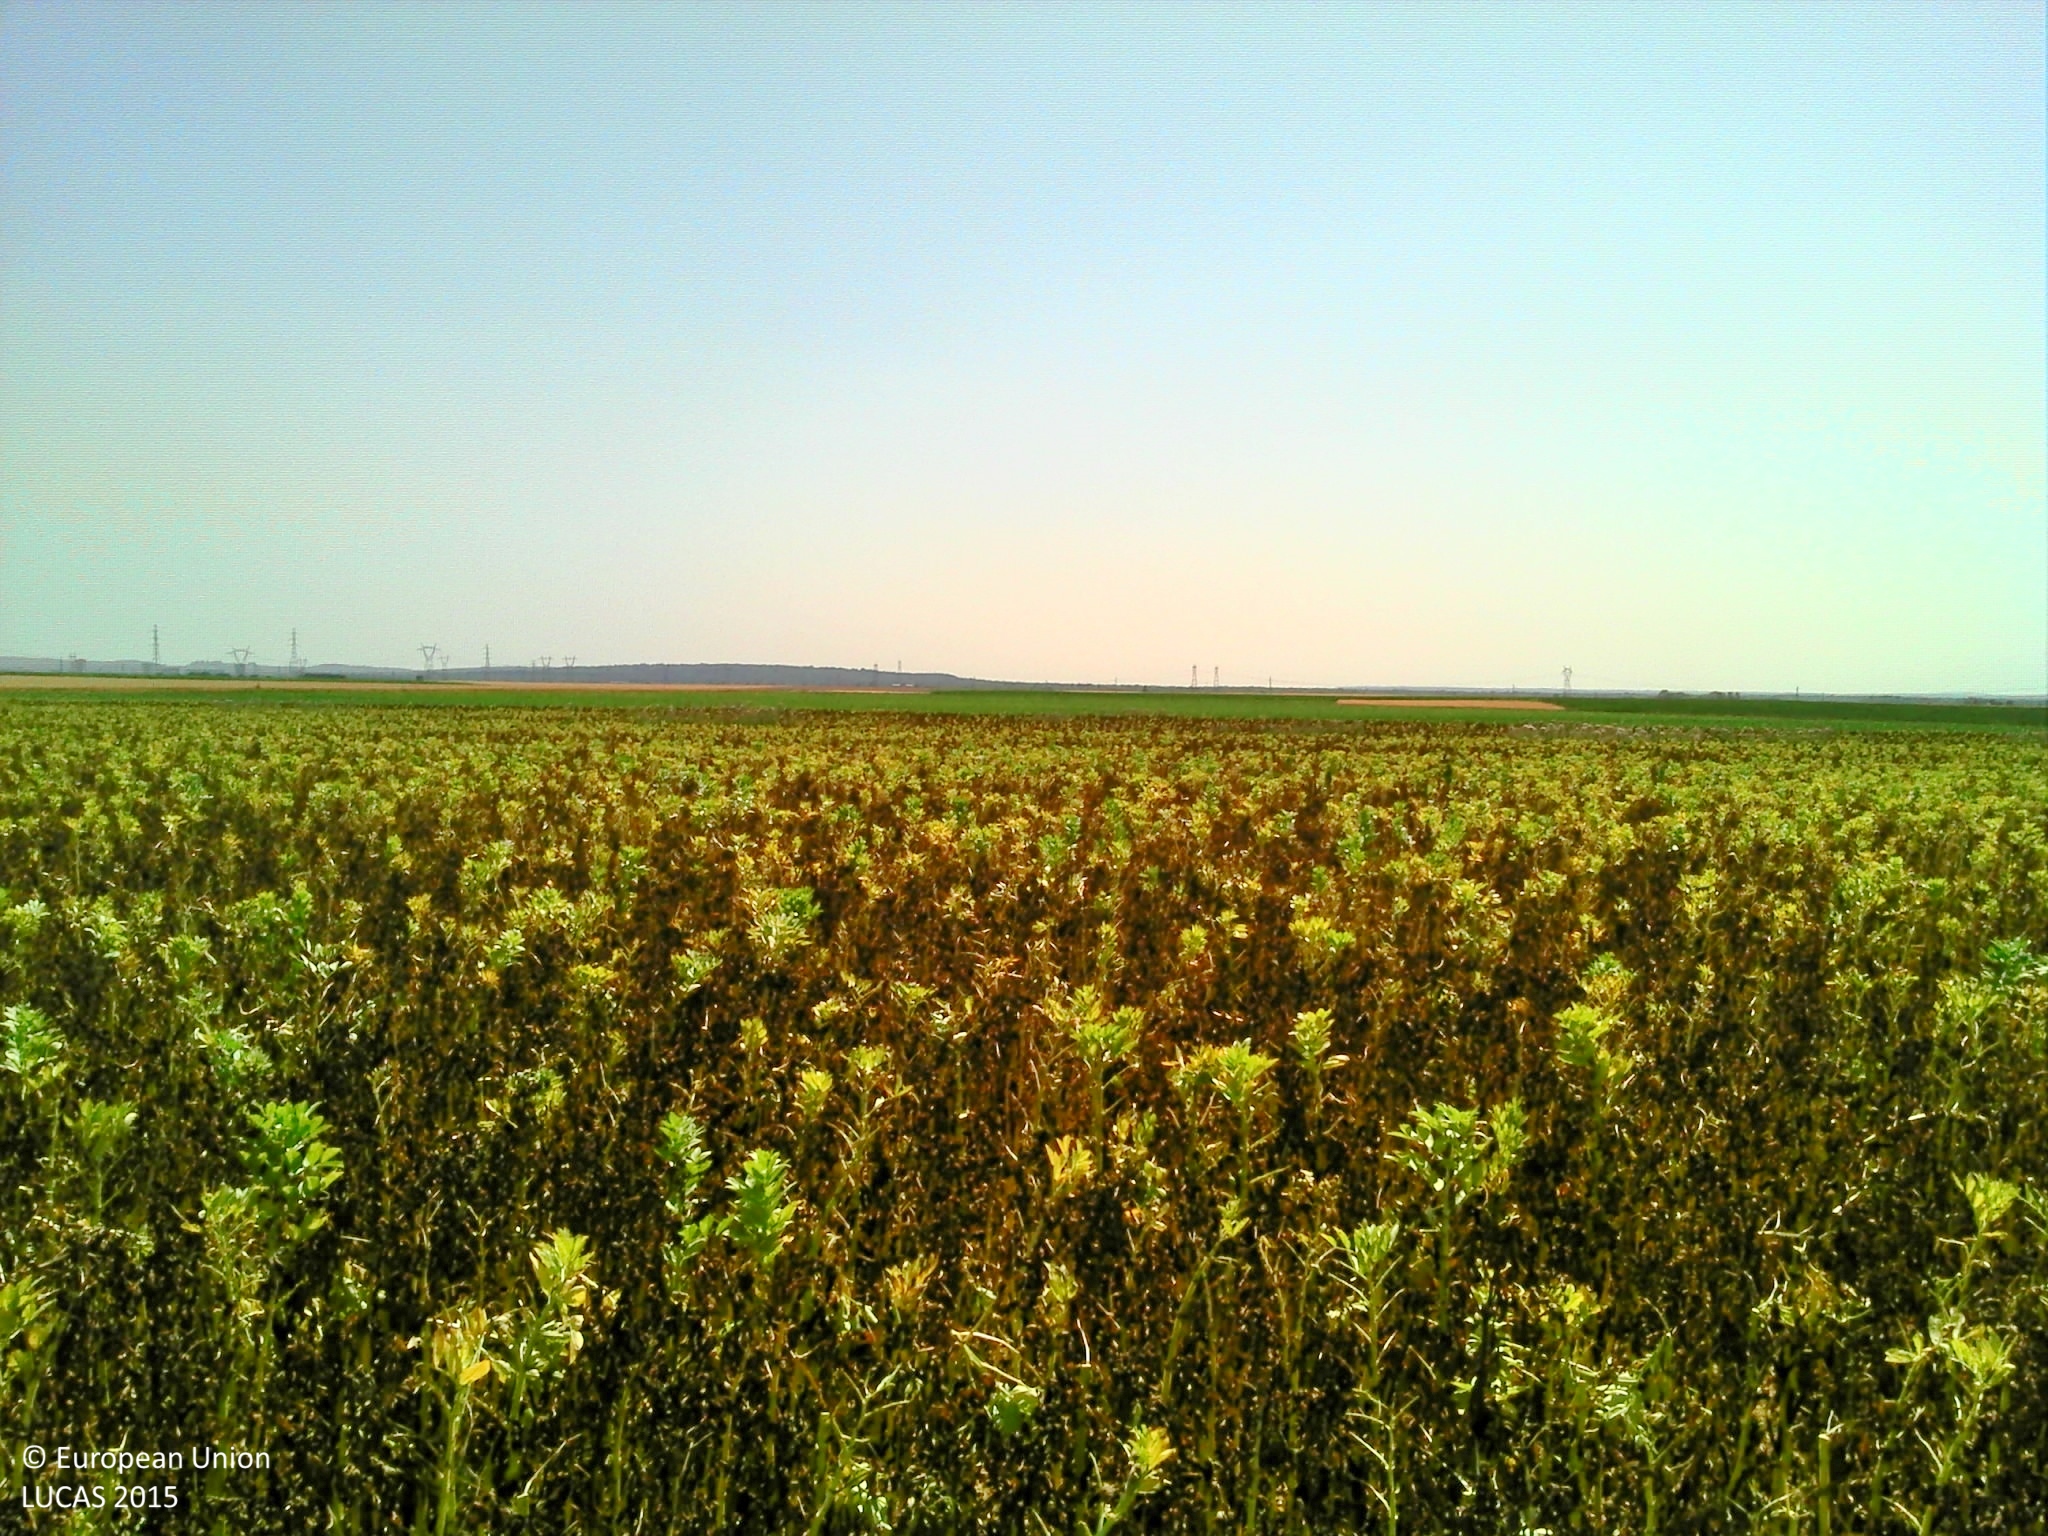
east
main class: Cropland
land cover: Dry pulses
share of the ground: > 75 %
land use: Agriculture (excluding fallow land and kitchen gardens)
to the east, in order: Dry pulses; Sugar beet
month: July
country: FR
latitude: 49.2434
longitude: 2.3916
